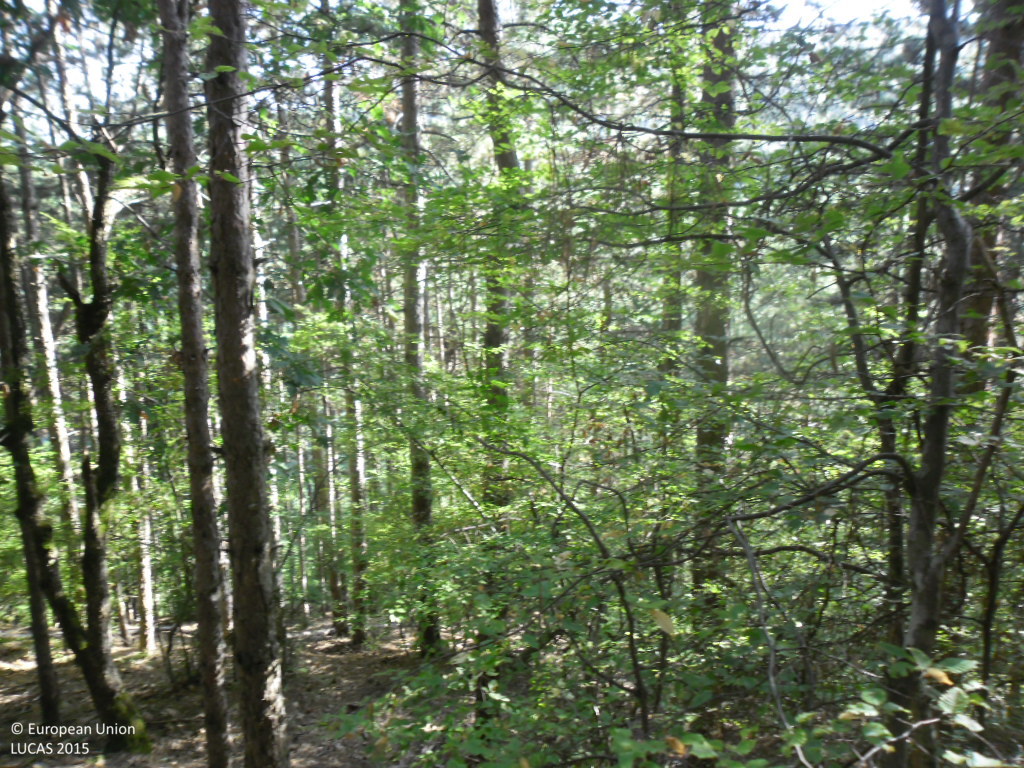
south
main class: Woodland
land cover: Pine dominated coniferous woodland
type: hemiboreal forest and nemoral coniferous forest and mixed broadleaved-coniferous forest
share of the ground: > 75 %
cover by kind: coniferous forest trees 85 %, broadleaved forest trees 10 %, unconsolidated bare surface 5 %
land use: Forestry
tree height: > 5 m
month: September
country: BG
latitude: 41.4547
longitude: 23.0785
